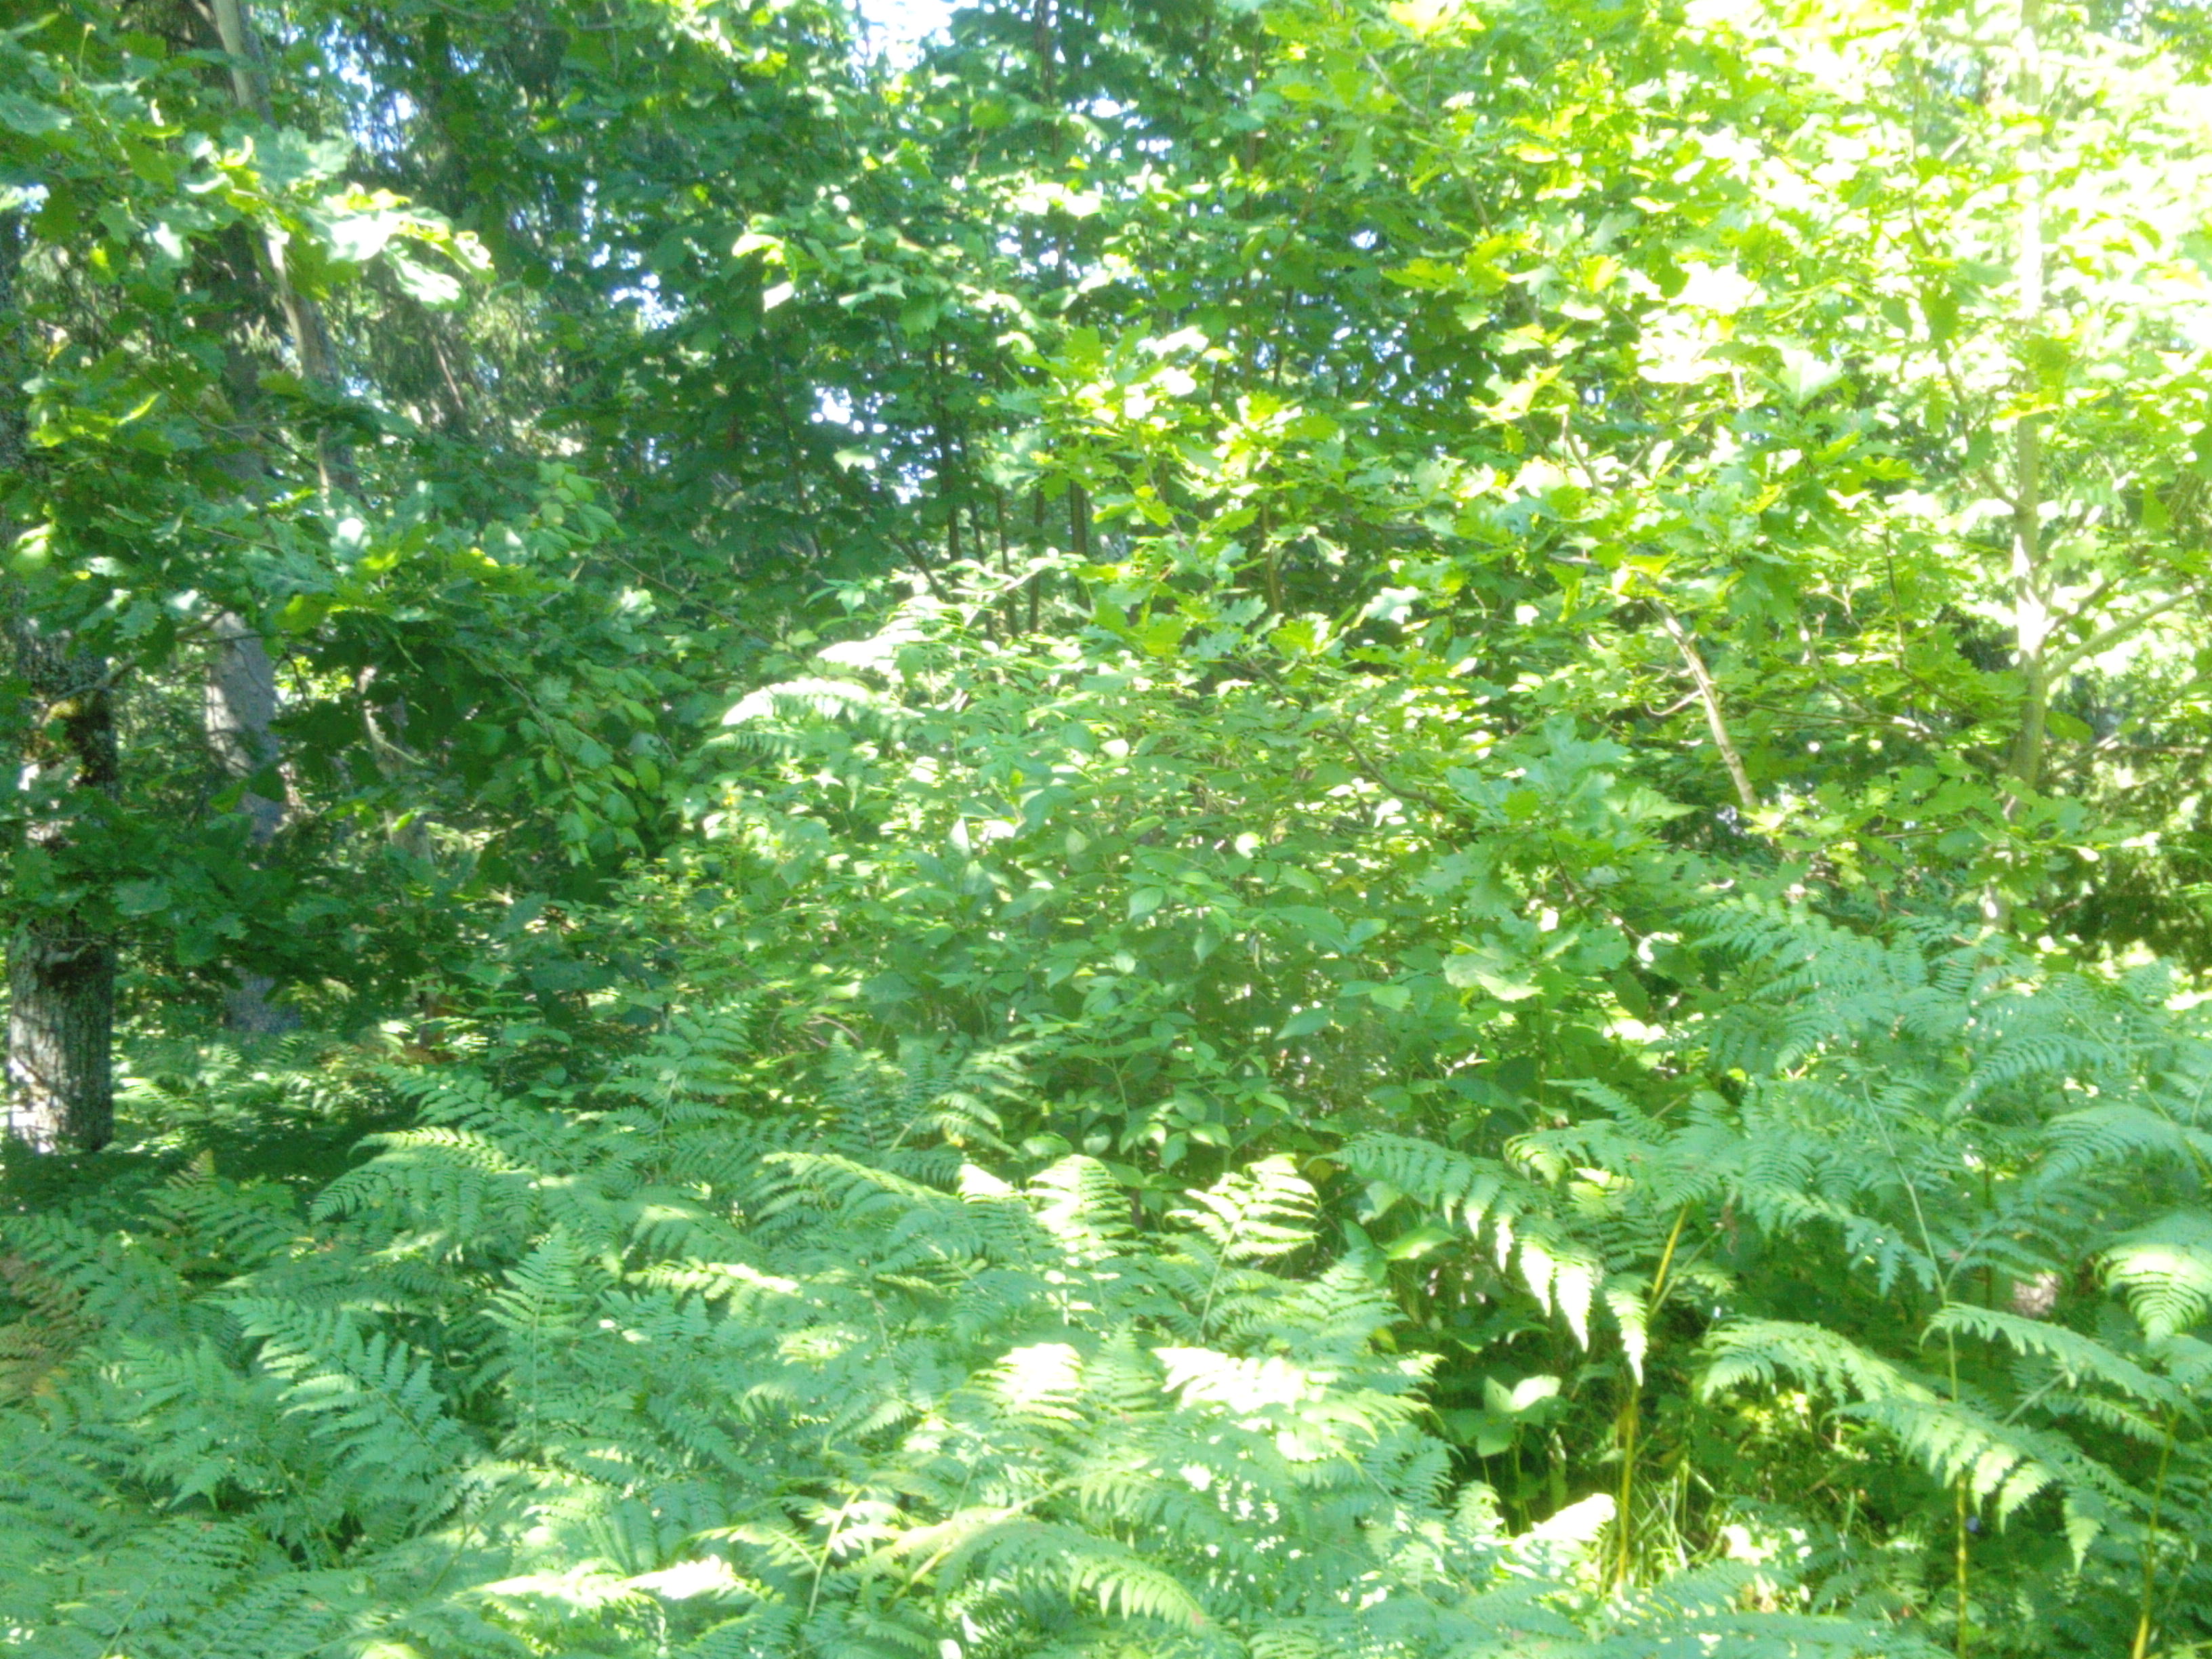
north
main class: Woodland
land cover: Spruce dominated mixed woodland
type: hemiboreal forest and nemoral coniferous forest and mixed broadleaved-coniferous forest
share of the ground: 50 - 75 %
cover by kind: broadleaved forest trees 45 %, coniferous forest trees 25 %, herbaceous plants 25 %, shrubs 5 %
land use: Forestry
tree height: > 5 m
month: August
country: LV
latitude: 56.9393
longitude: 21.9297
